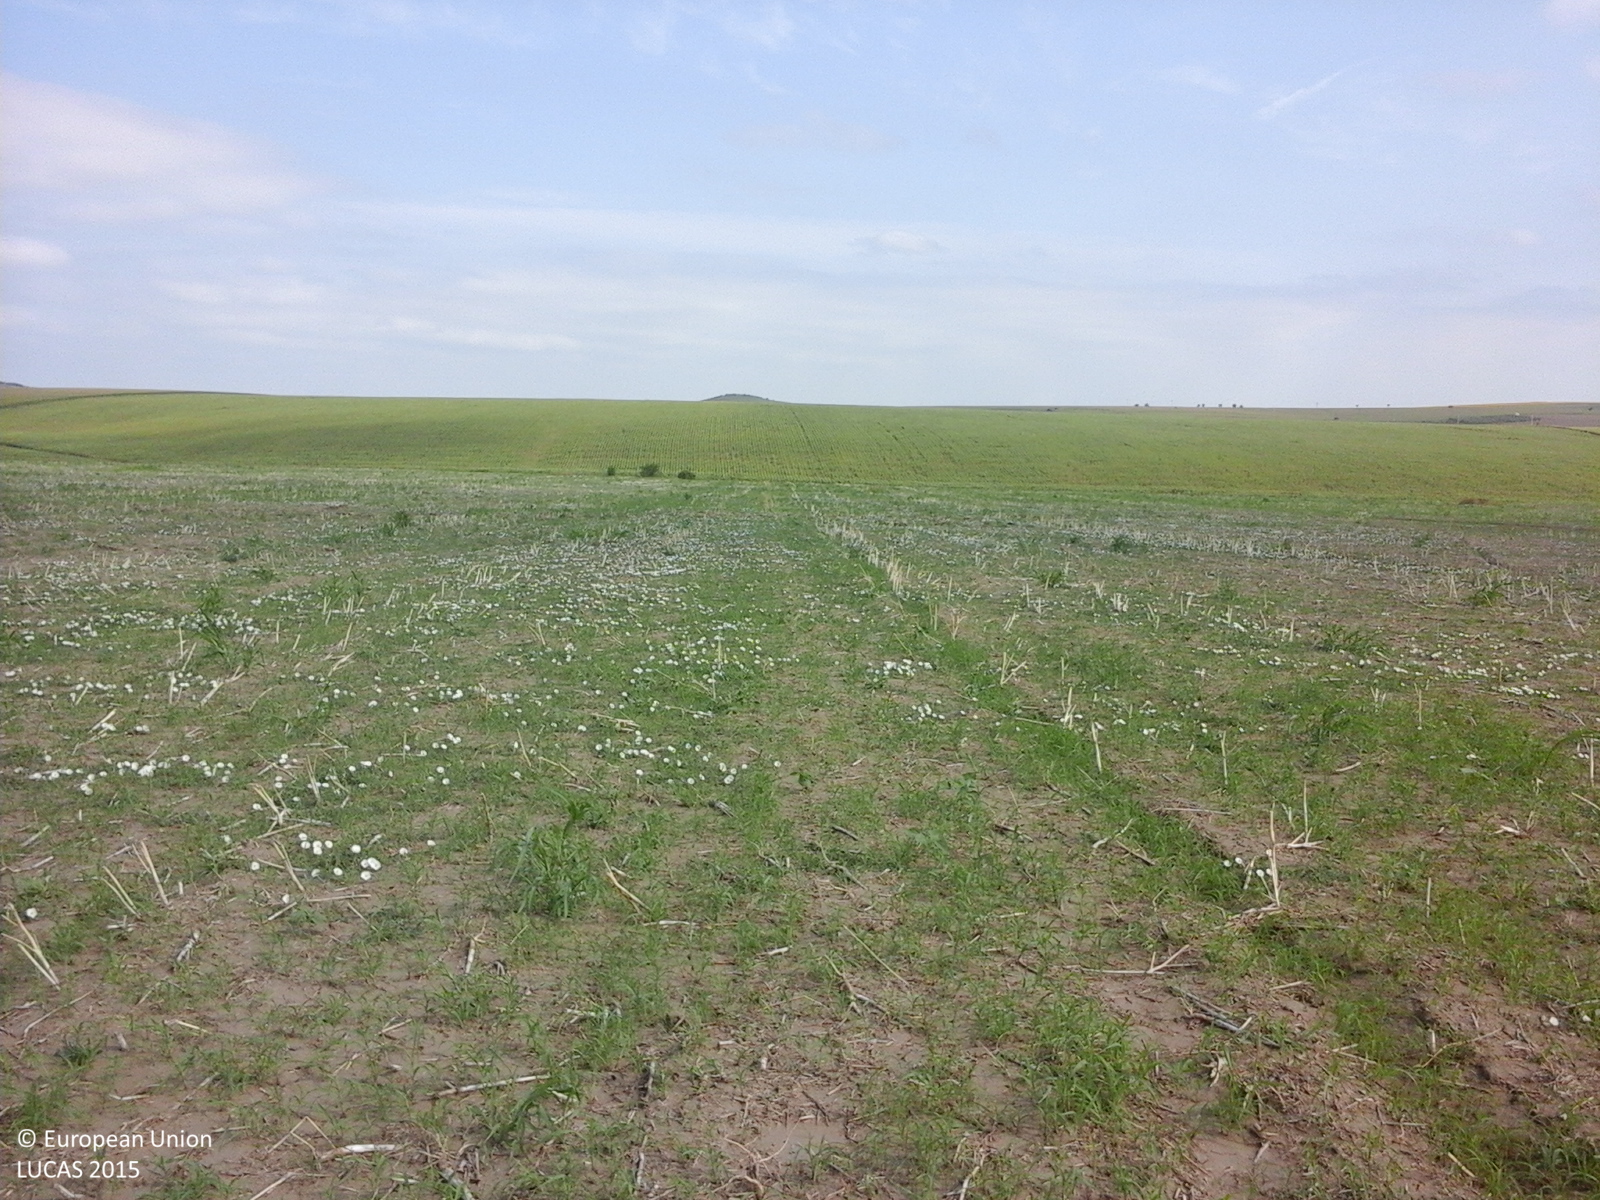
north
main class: Cropland
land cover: Rape and turnip rape
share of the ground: 10 - 25 %
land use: Agriculture (excluding fallow land and kitchen gardens)
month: August
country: RO
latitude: 45.0916
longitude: 28.9897
